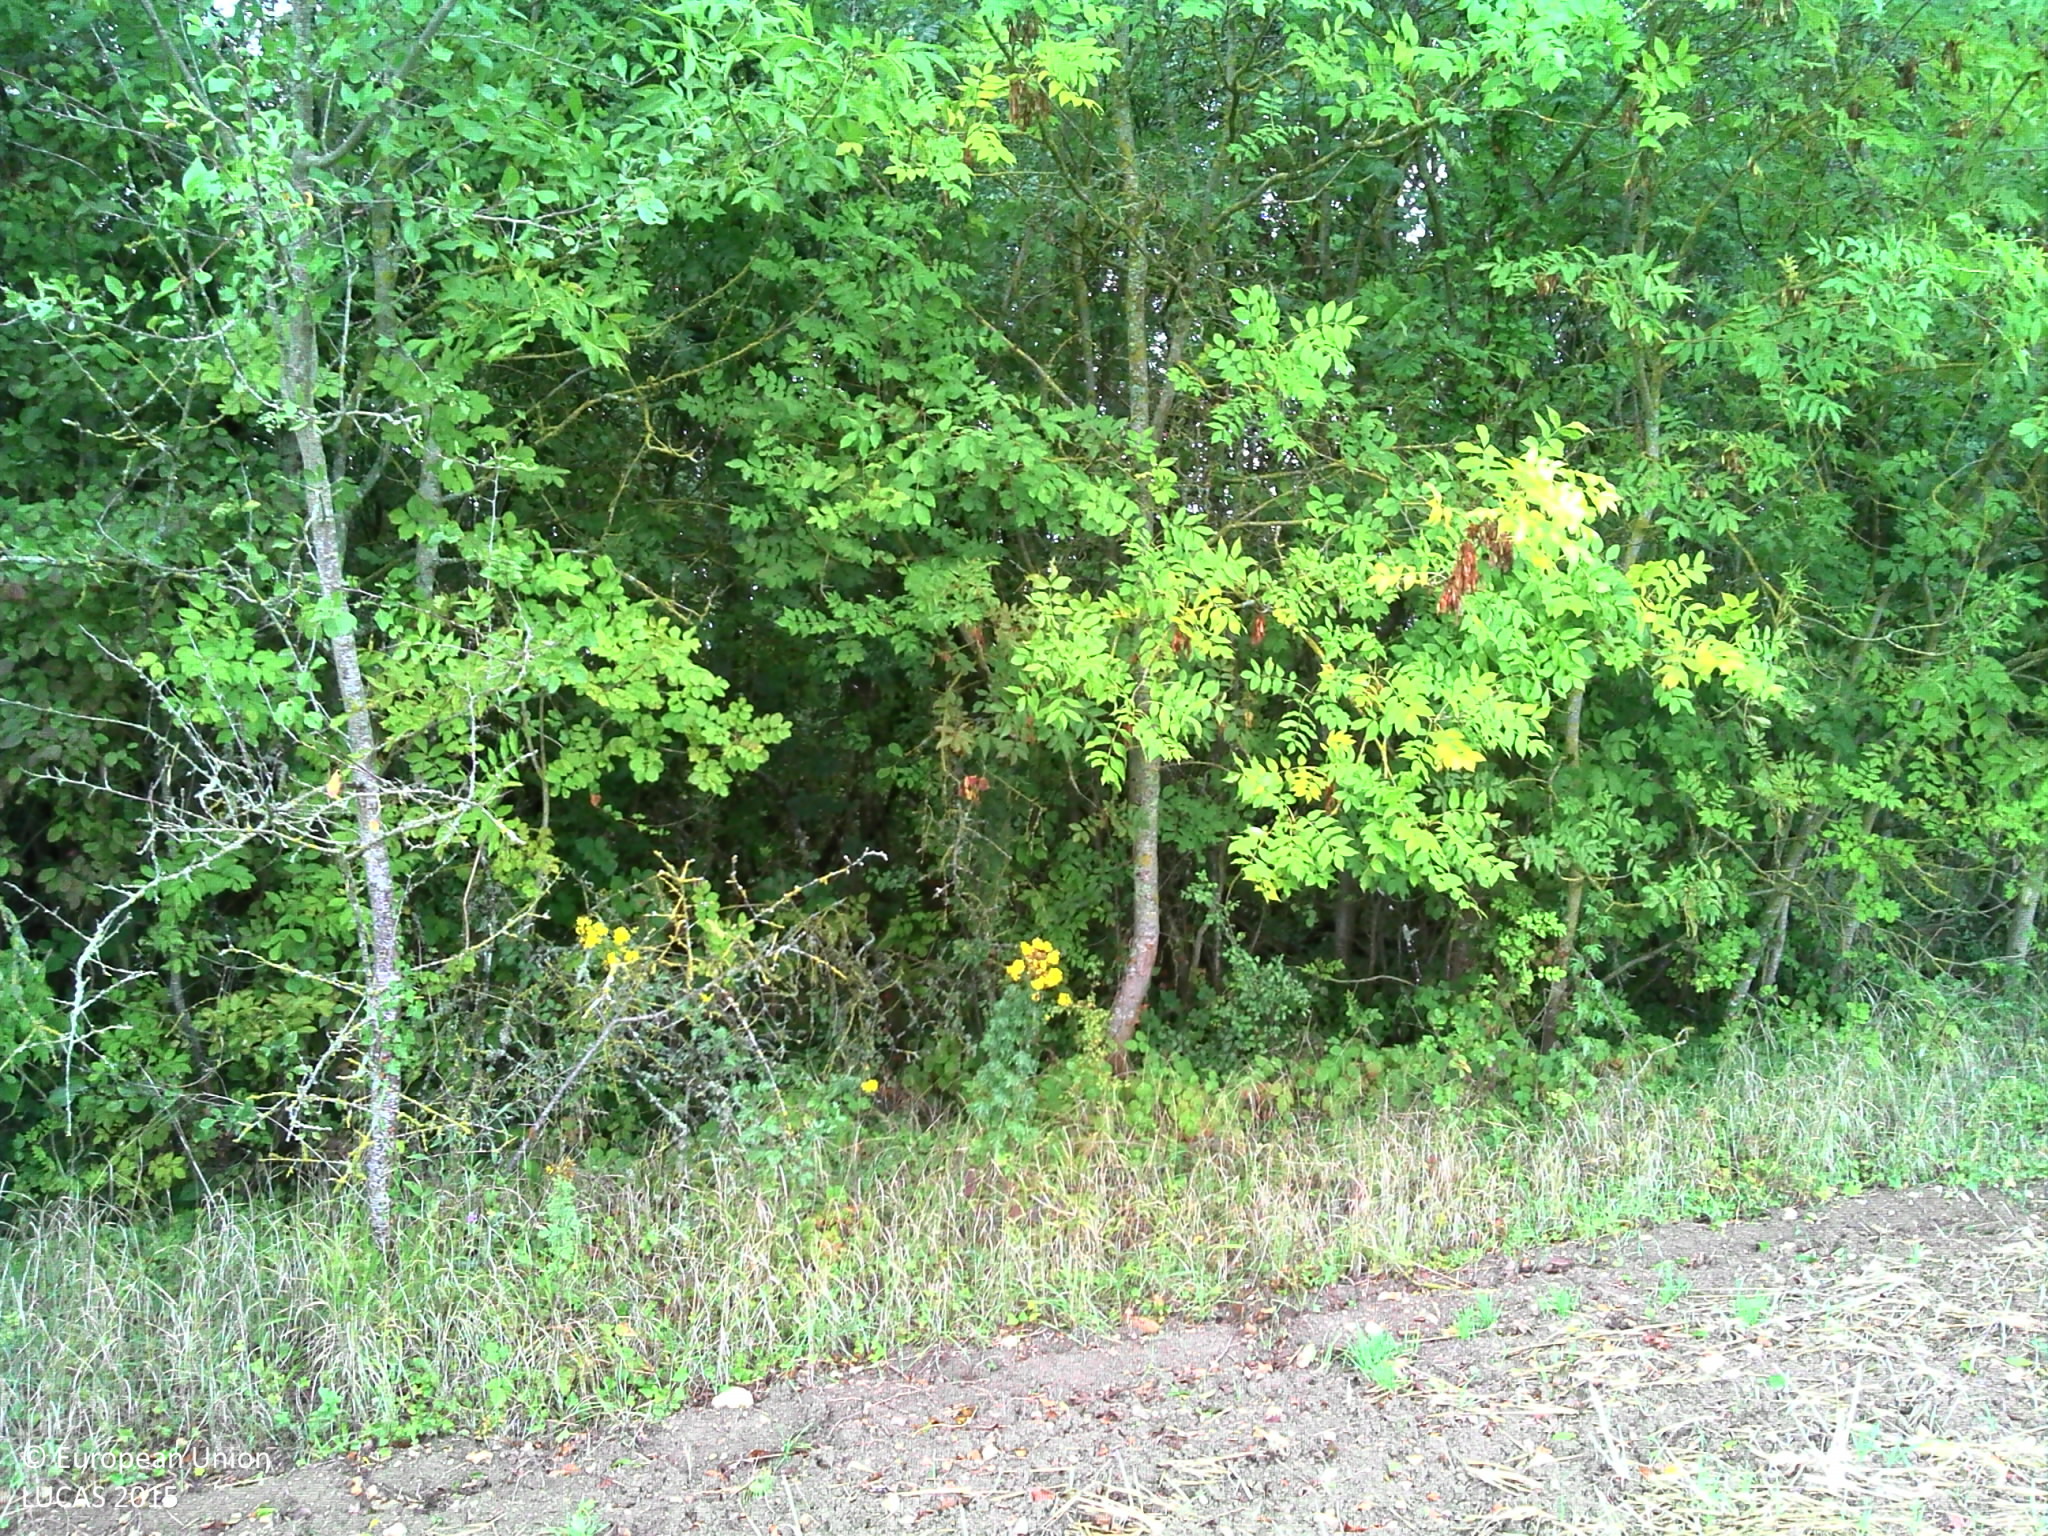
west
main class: Cropland
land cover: Common wheat
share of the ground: > 75 %
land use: Agriculture (excluding fallow land and kitchen gardens)
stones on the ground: < 10 %
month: September
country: FR
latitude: 48.4346
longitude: 3.0041
